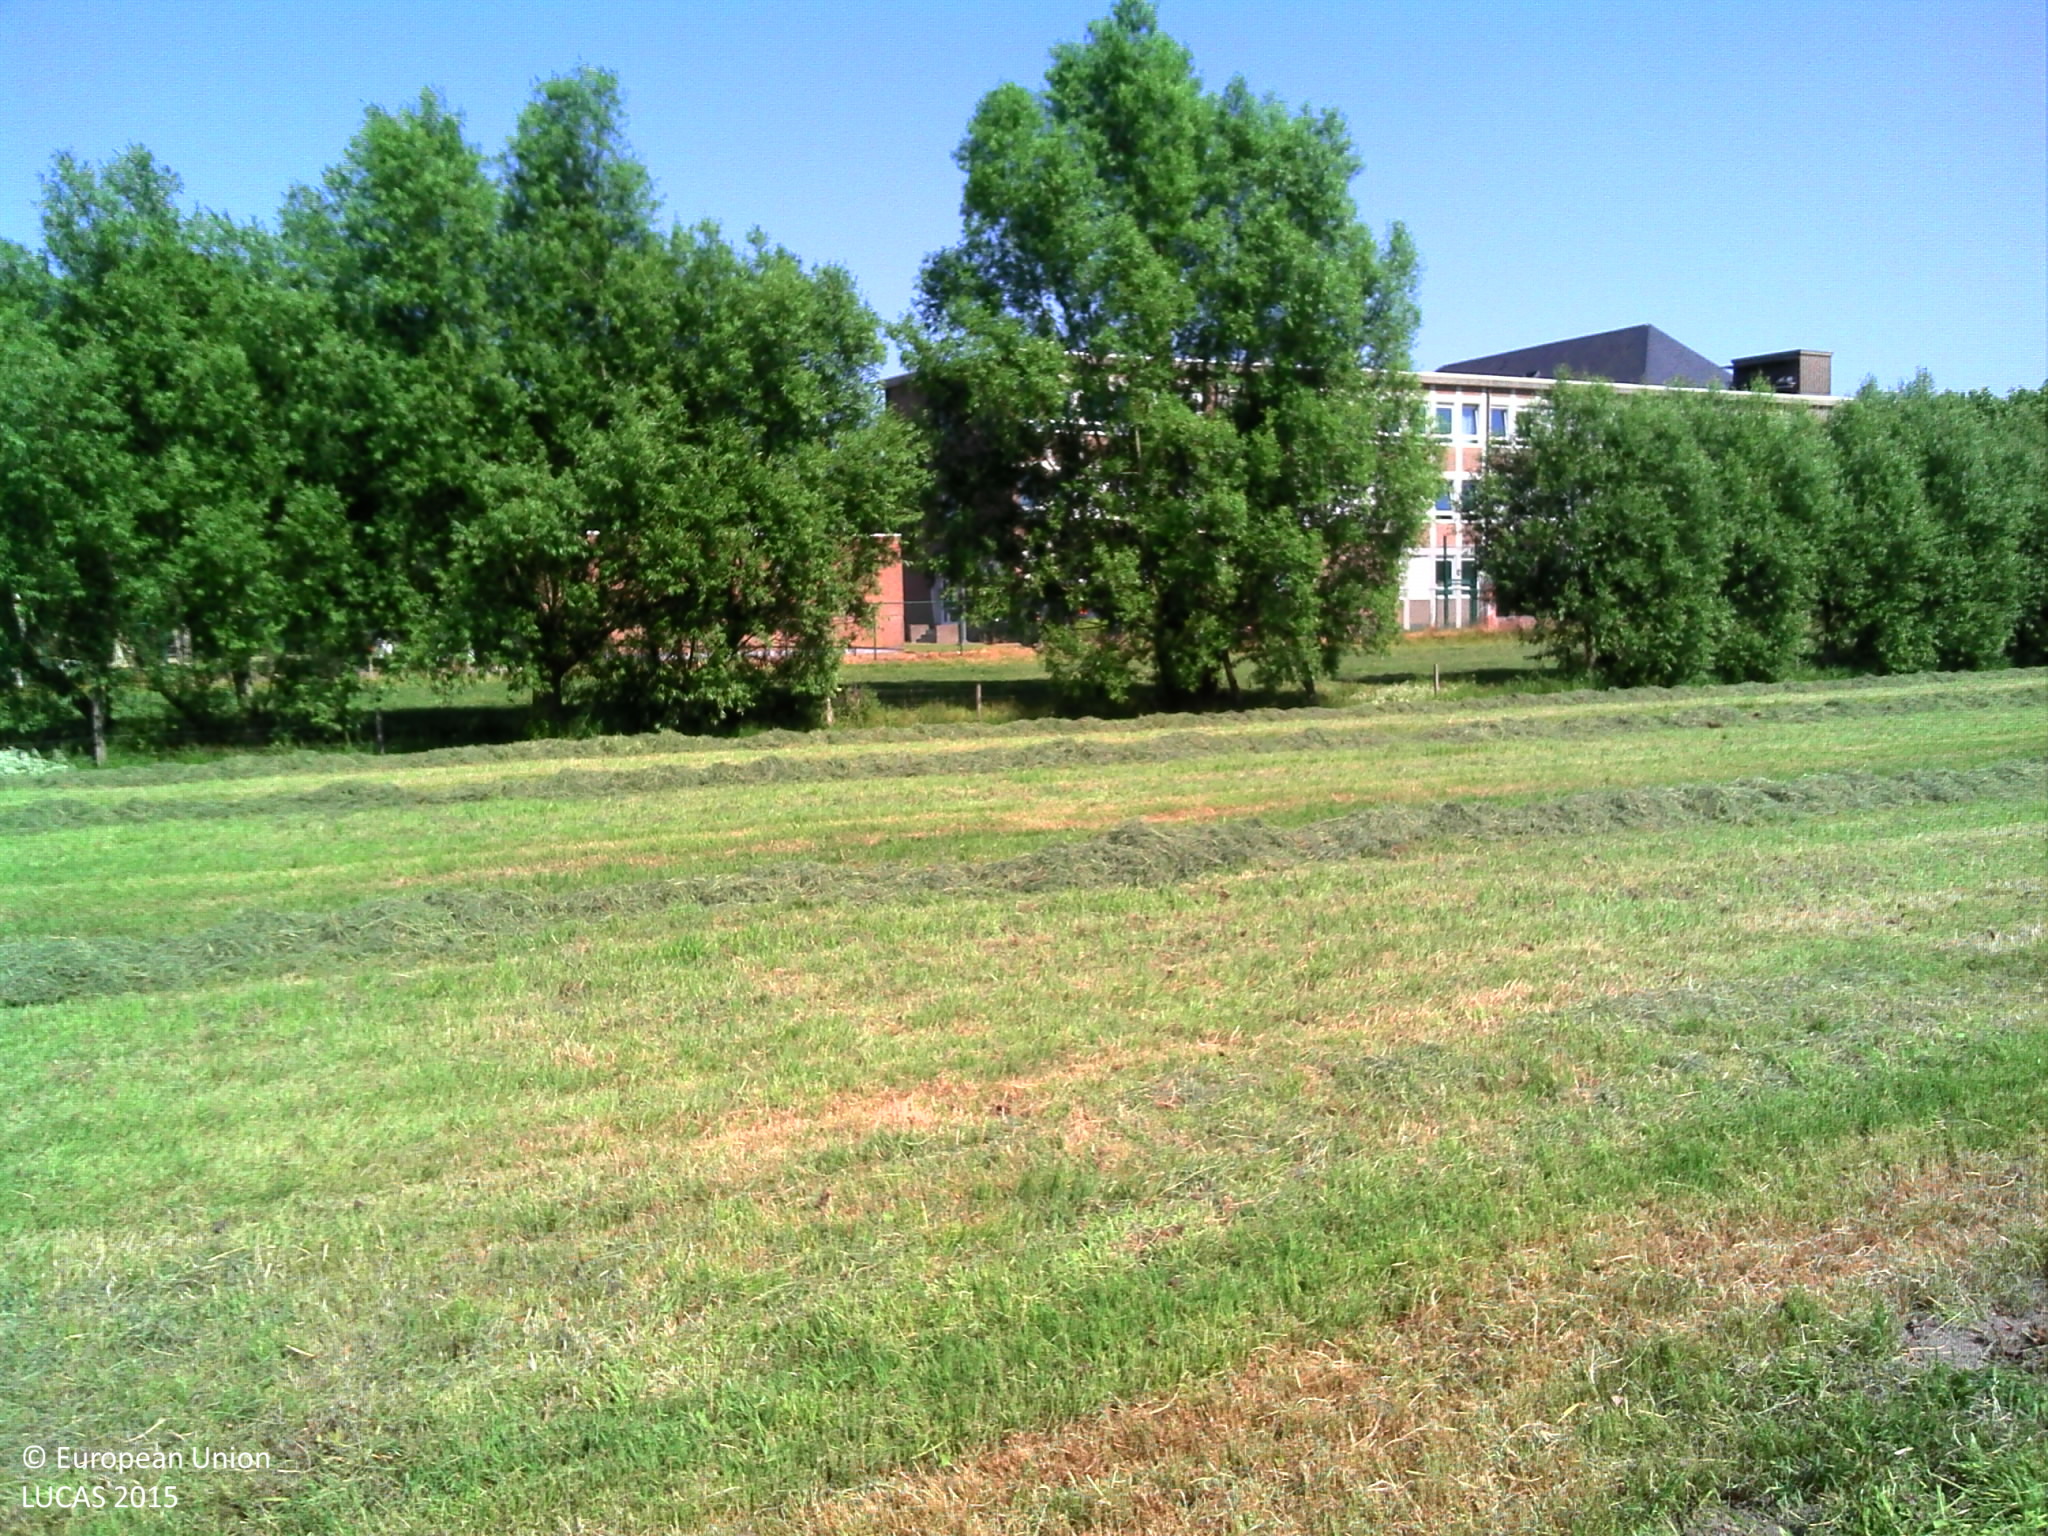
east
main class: Grassland
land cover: Grassland without tree/shrub cover
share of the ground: > 75 %
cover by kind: herbaceous plants 100 %
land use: Agriculture (excluding fallow land and kitchen gardens)
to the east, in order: Grassland without tree/shrub cover; Fences; Lines of trees; Ditches and canals; Fences; Grassland without tree/shrub cover; Artificial constructions in urban areas
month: June
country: BE
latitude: 51.1262
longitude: 3.6630
